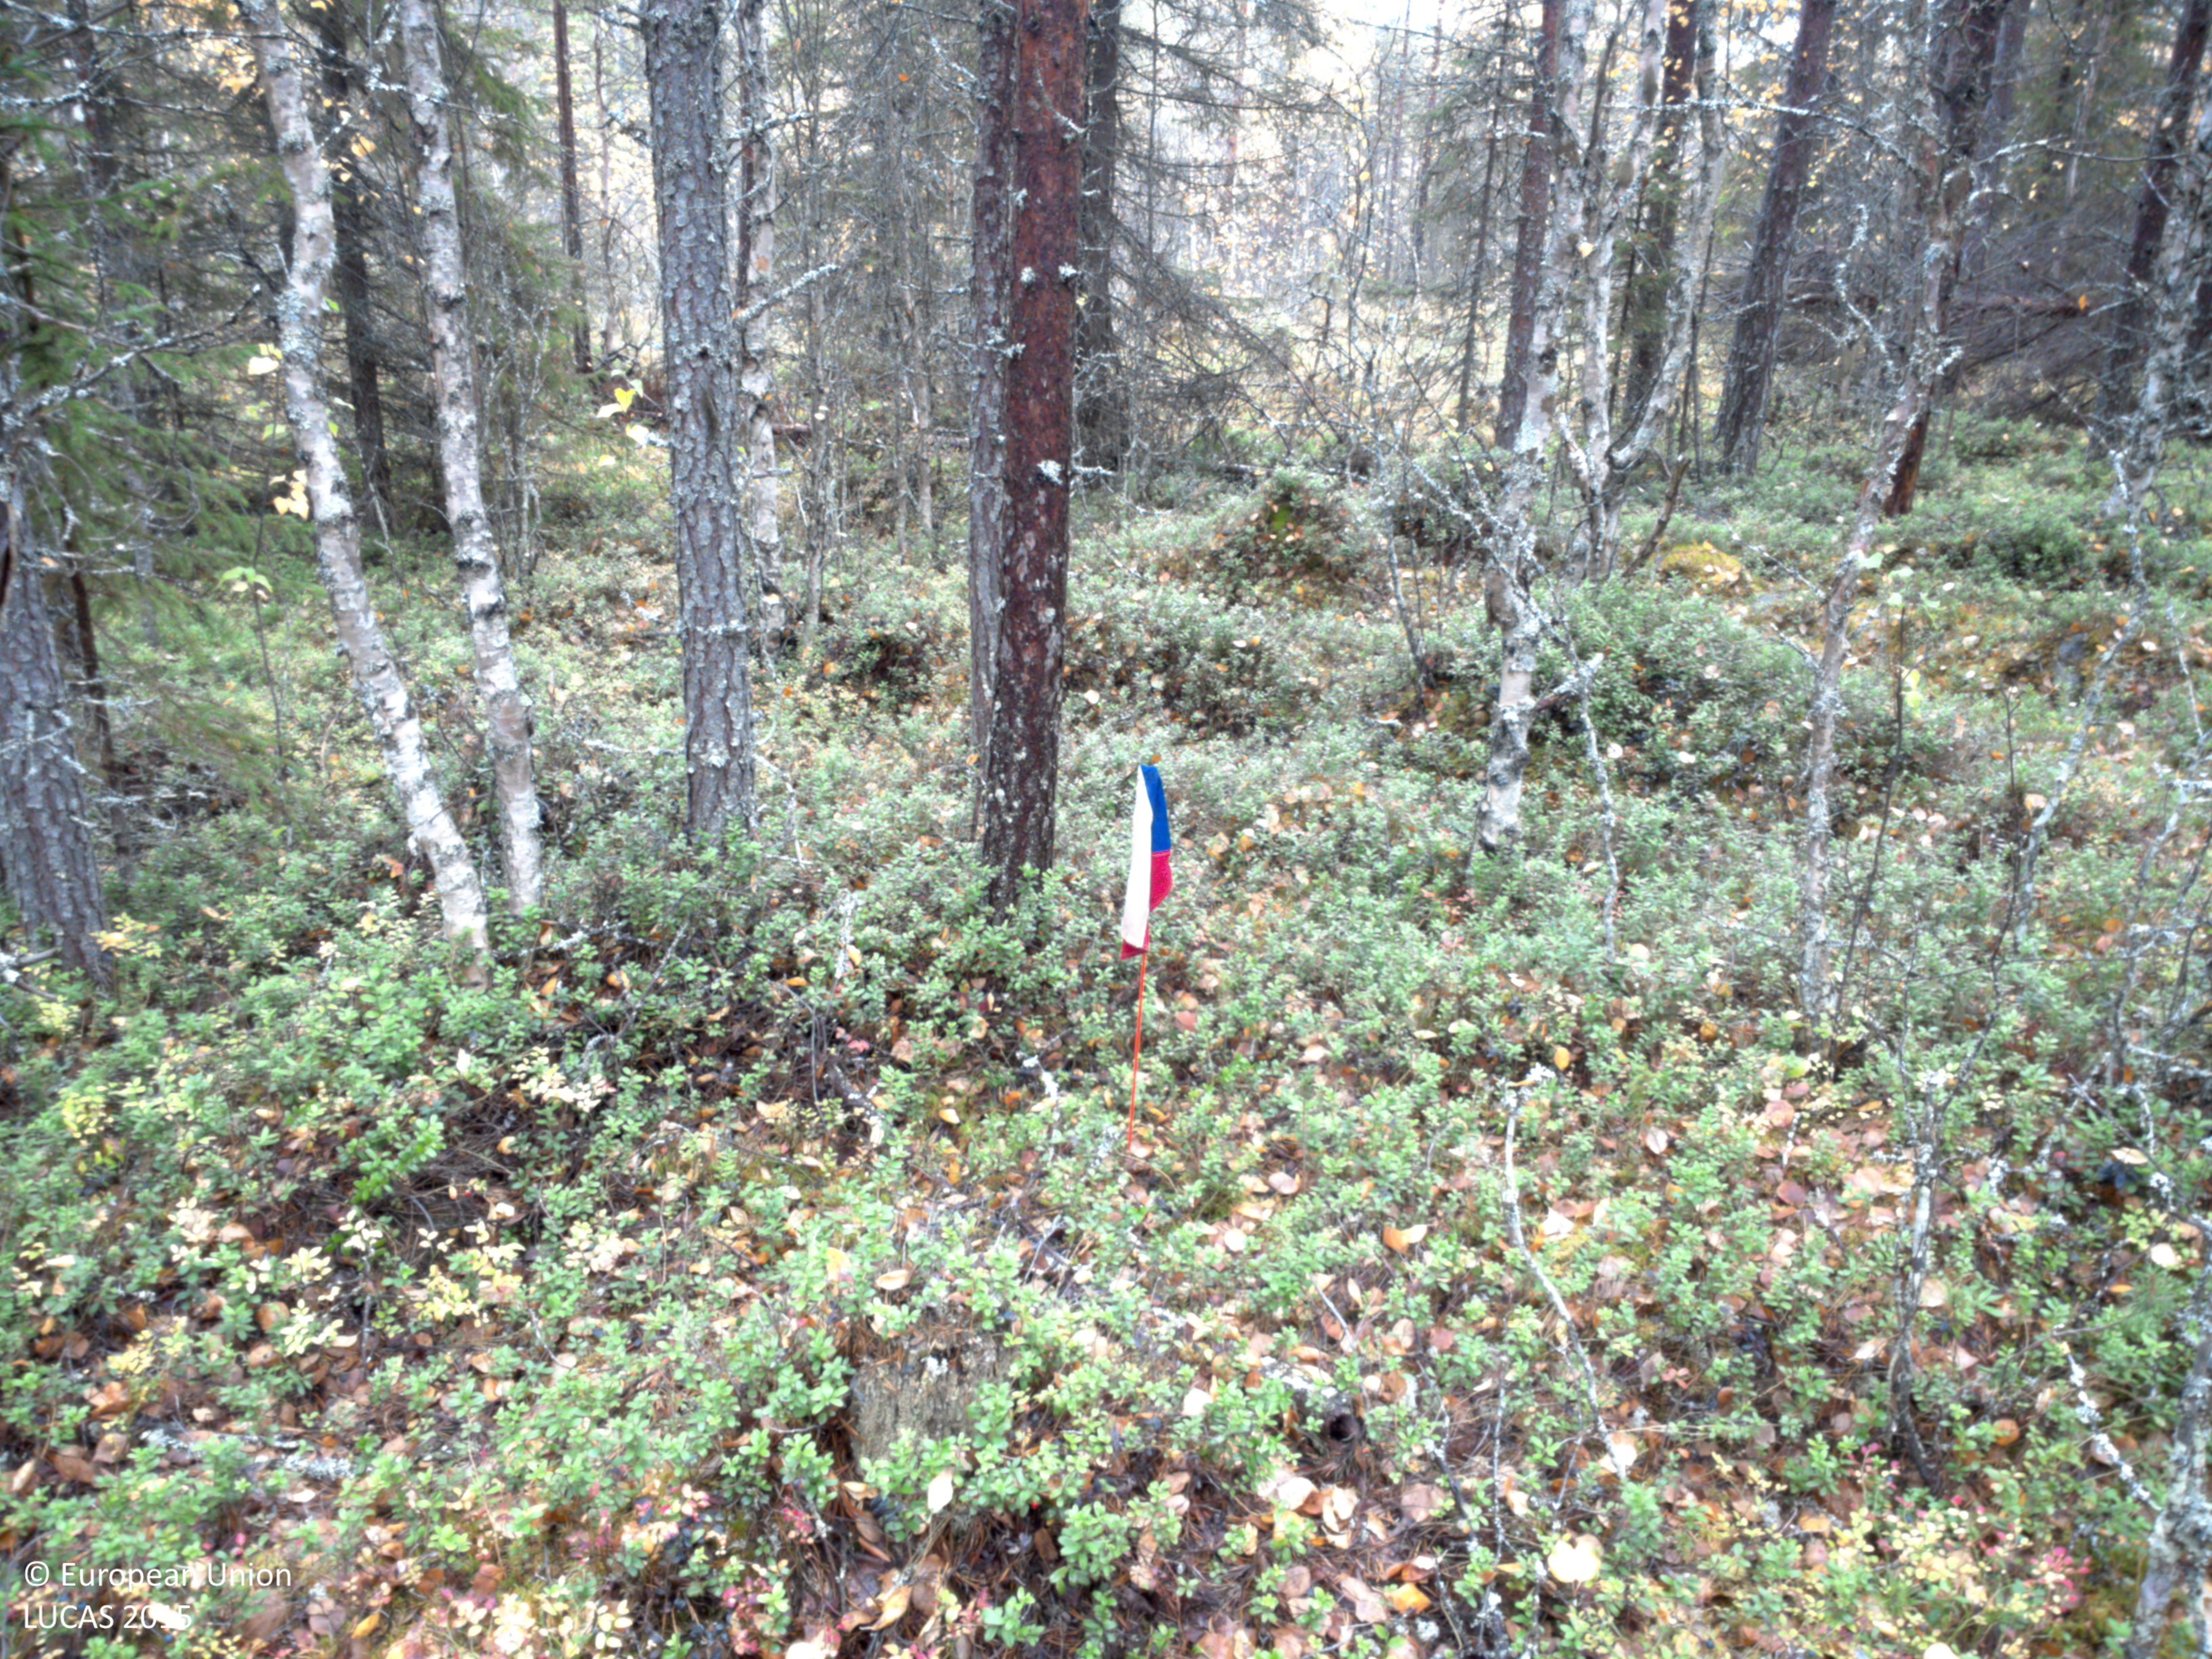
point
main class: Woodland
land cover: Pine dominated coniferous woodland
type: boreal forest
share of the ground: 50 - 75 %
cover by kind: coniferous forest trees 55 %, shrubs 20 %, lichens and mosses 10 %, broadleaved forest trees 5 %, herbaceous plants 5 %, consolidated bare surface 5 %
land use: Forestry
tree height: > 5 m
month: September
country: SE
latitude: 64.9477
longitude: 18.9185
